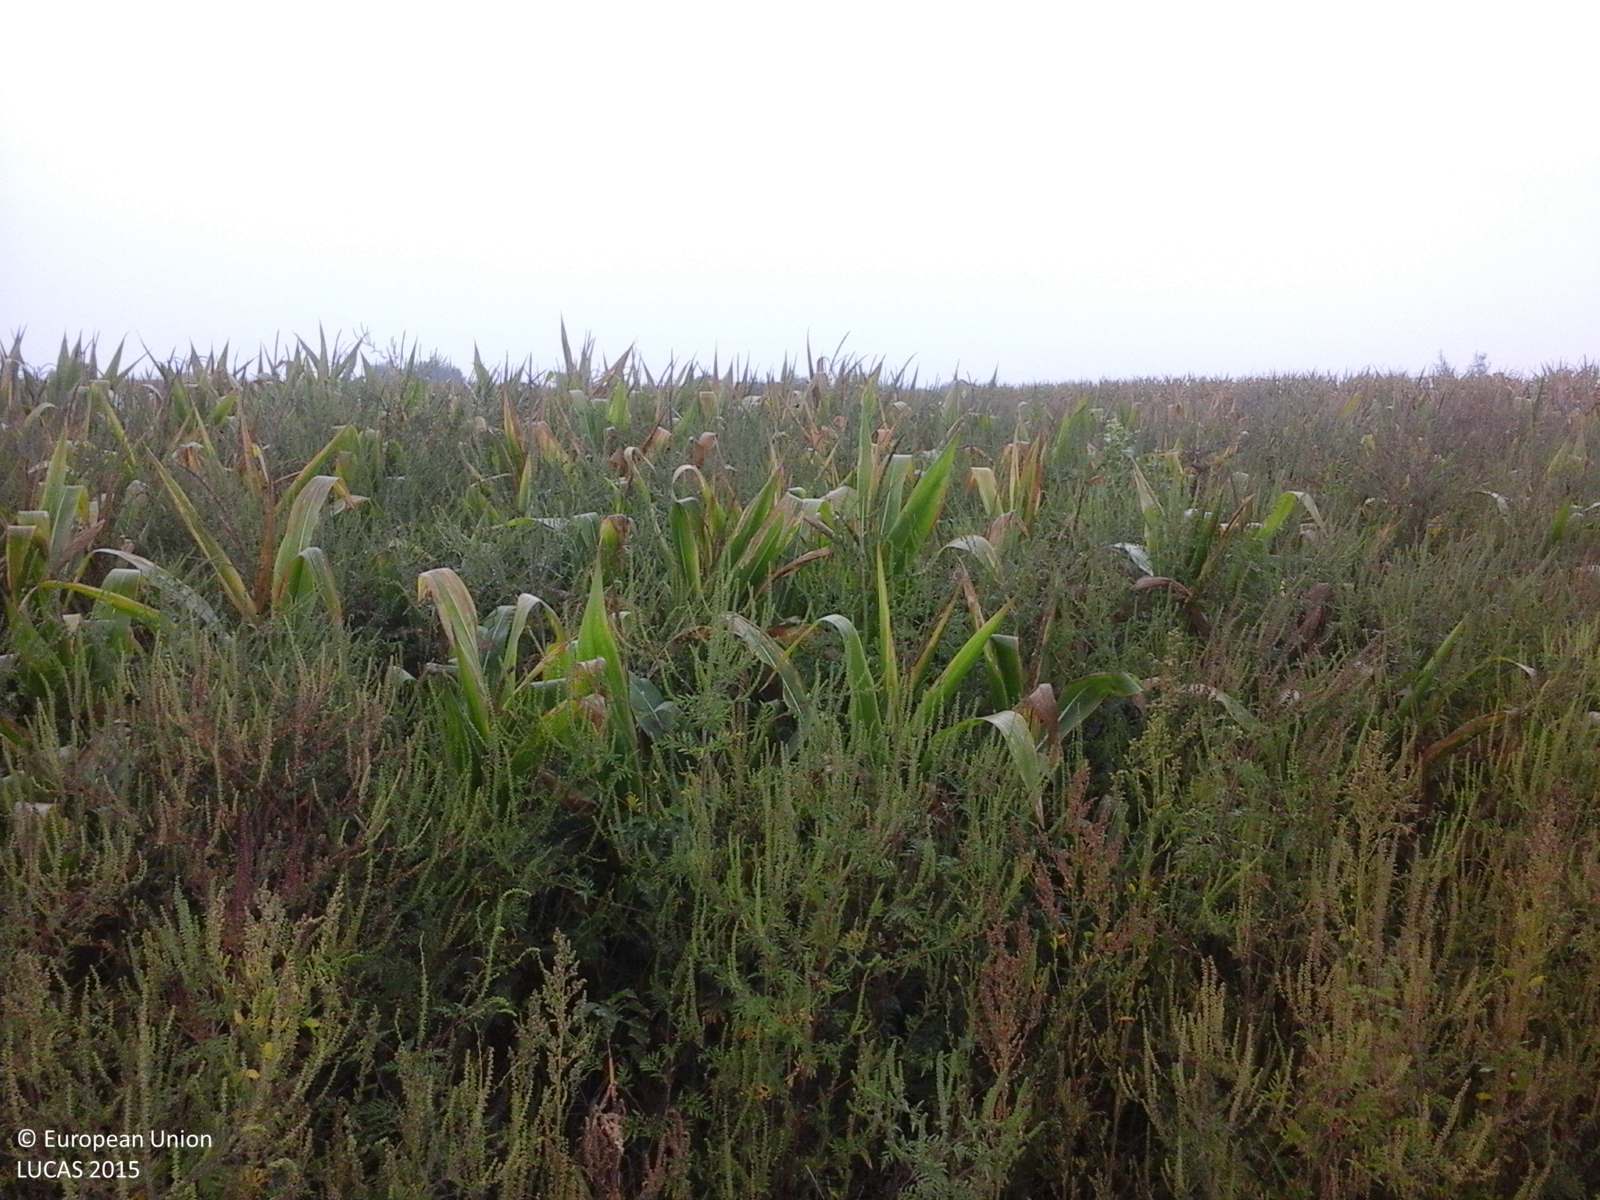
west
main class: Cropland
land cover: Maize
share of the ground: > 75 %
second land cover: Spontaneously vegetated surfaces
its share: > 75 %
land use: Agriculture (excluding fallow land and kitchen gardens)
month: September
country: RO
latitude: 47.4090
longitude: 22.0969
